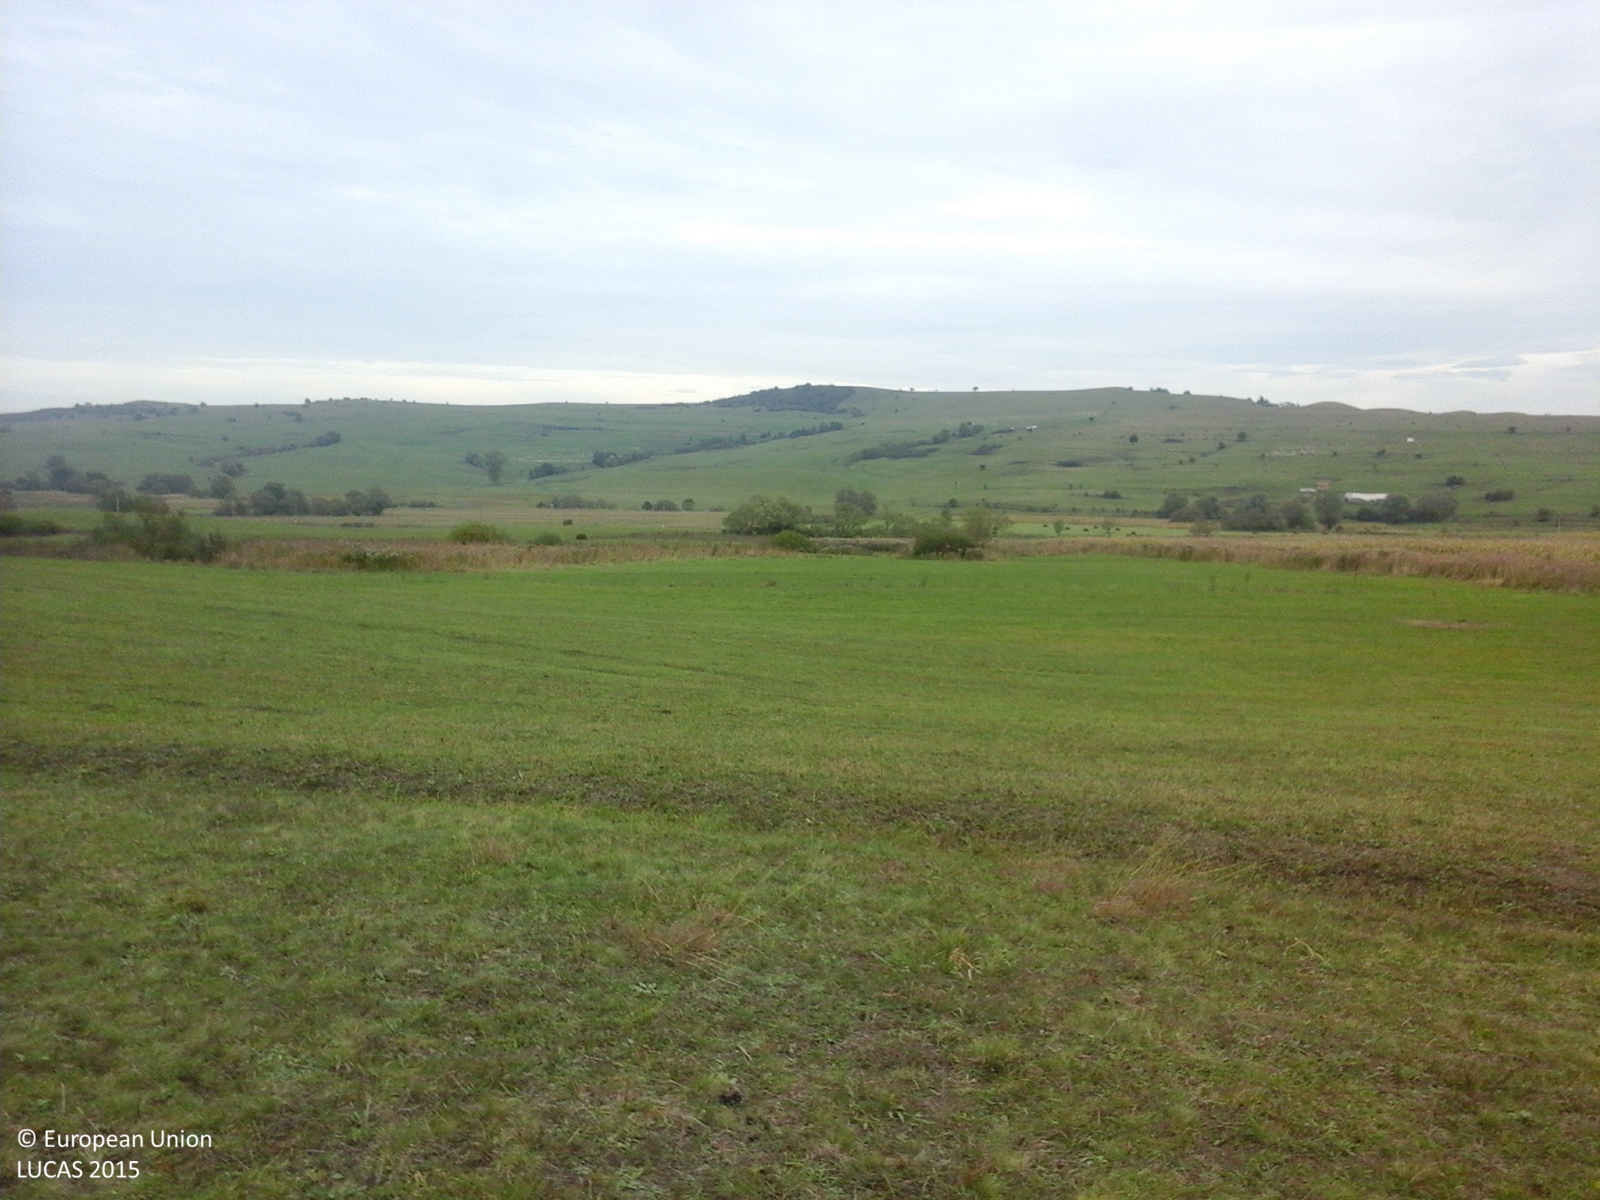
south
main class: Grassland
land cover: Grassland without tree/shrub cover
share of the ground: > 75 %
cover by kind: herbaceous plants 100 %
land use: Agriculture (excluding fallow land and kitchen gardens)
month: October
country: RO
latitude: 46.0521
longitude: 24.8904
